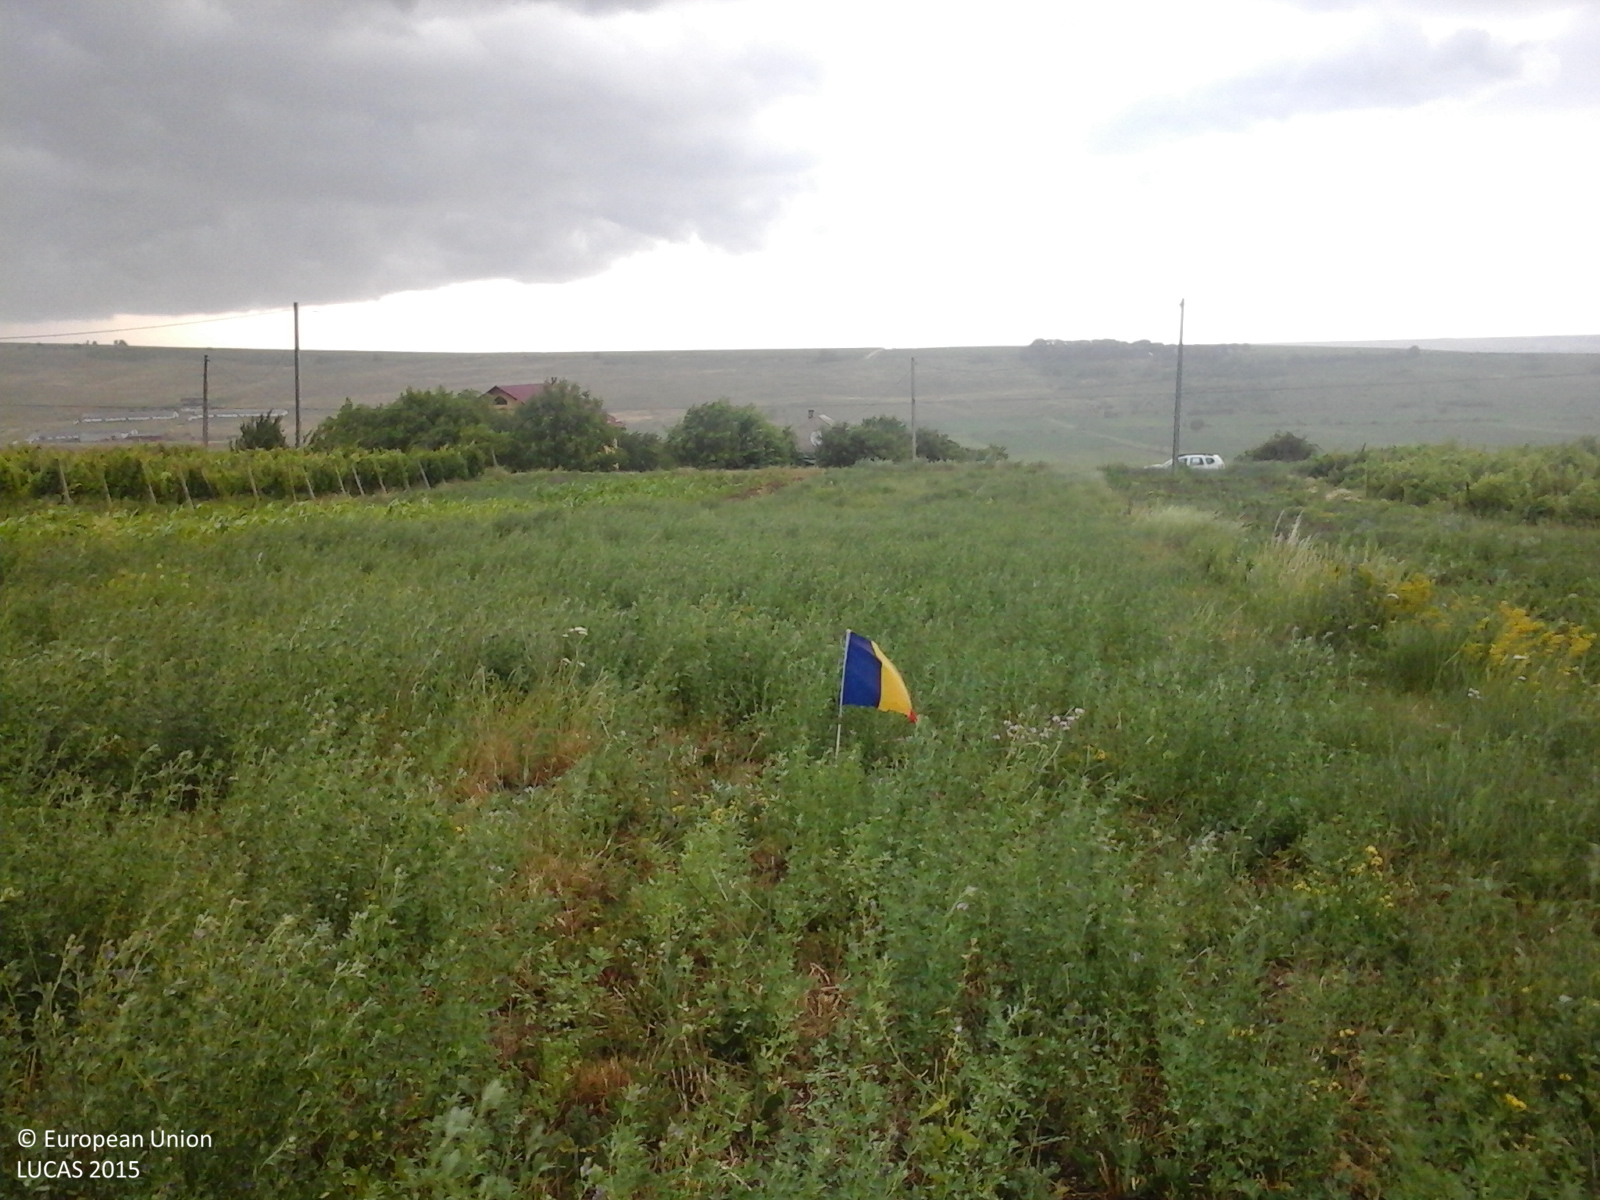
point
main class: Cropland
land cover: Lucerne
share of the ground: > 75 %
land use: Agriculture (excluding fallow land and kitchen gardens)
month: June
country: RO
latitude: 47.3261
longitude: 26.9170
